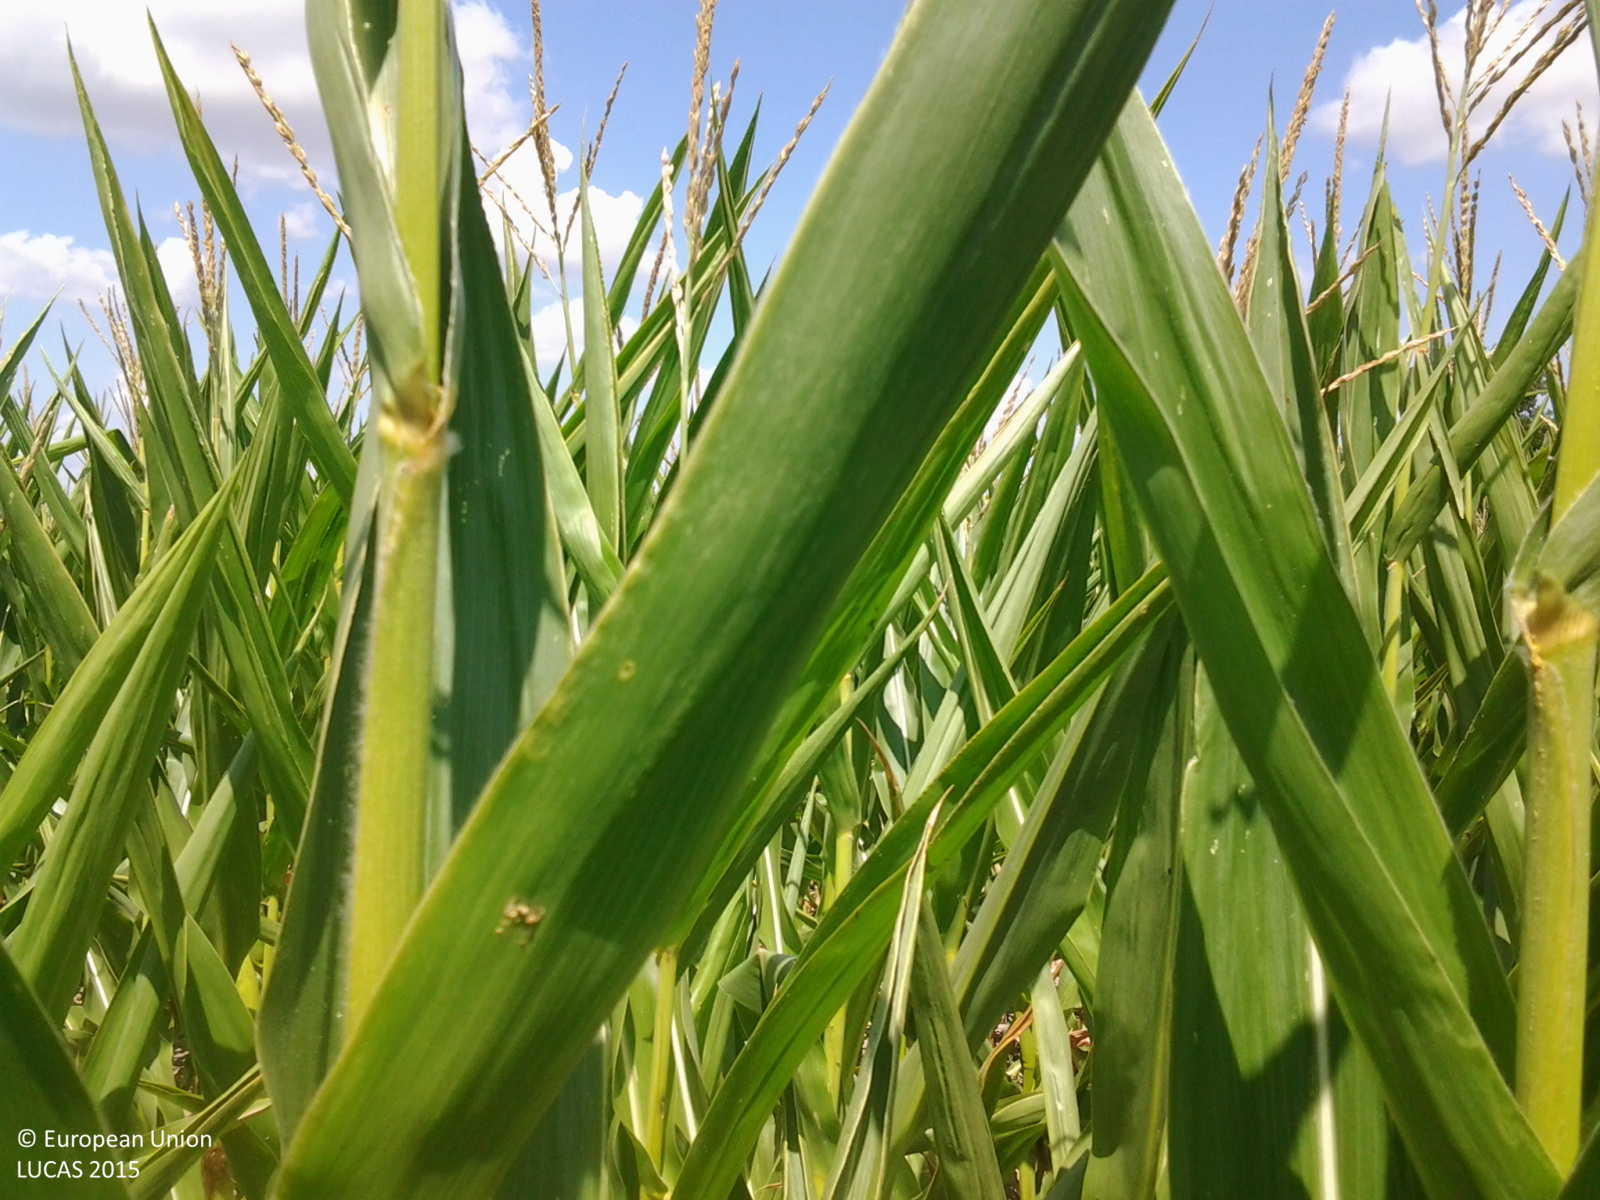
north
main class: Cropland
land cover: Maize
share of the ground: > 75 %
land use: Agriculture (excluding fallow land and kitchen gardens)
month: July
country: HU
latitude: 46.7300
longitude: 21.4886
